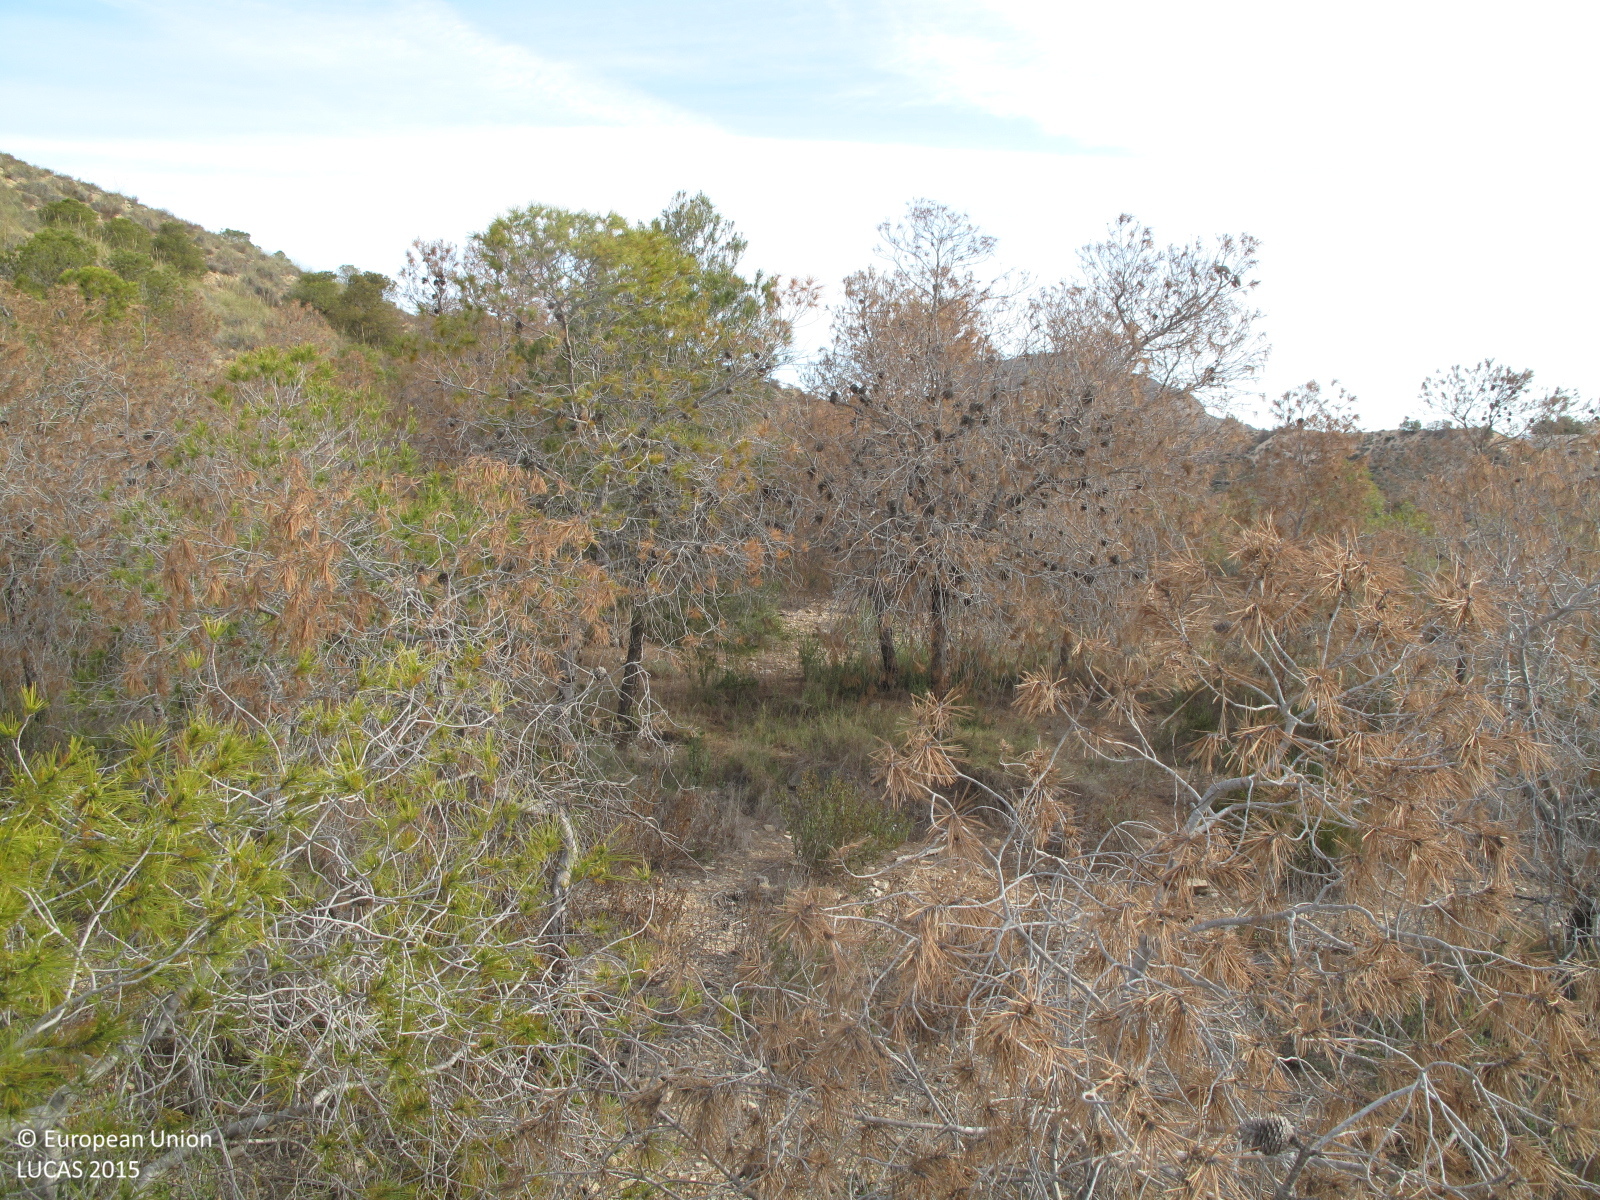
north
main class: Woodland
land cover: Pine dominated coniferous woodland
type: coniferous forest of the mediterranean region
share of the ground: 25 - 50 %
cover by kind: coniferous forest trees 40 %, consolidated bare surface 40 %, shrubs 10 %, herbaceous plants 10 %
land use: Semi-natural and natural areas not in use
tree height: < 5 m
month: April
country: ES
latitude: 38.4596
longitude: -0.5186
